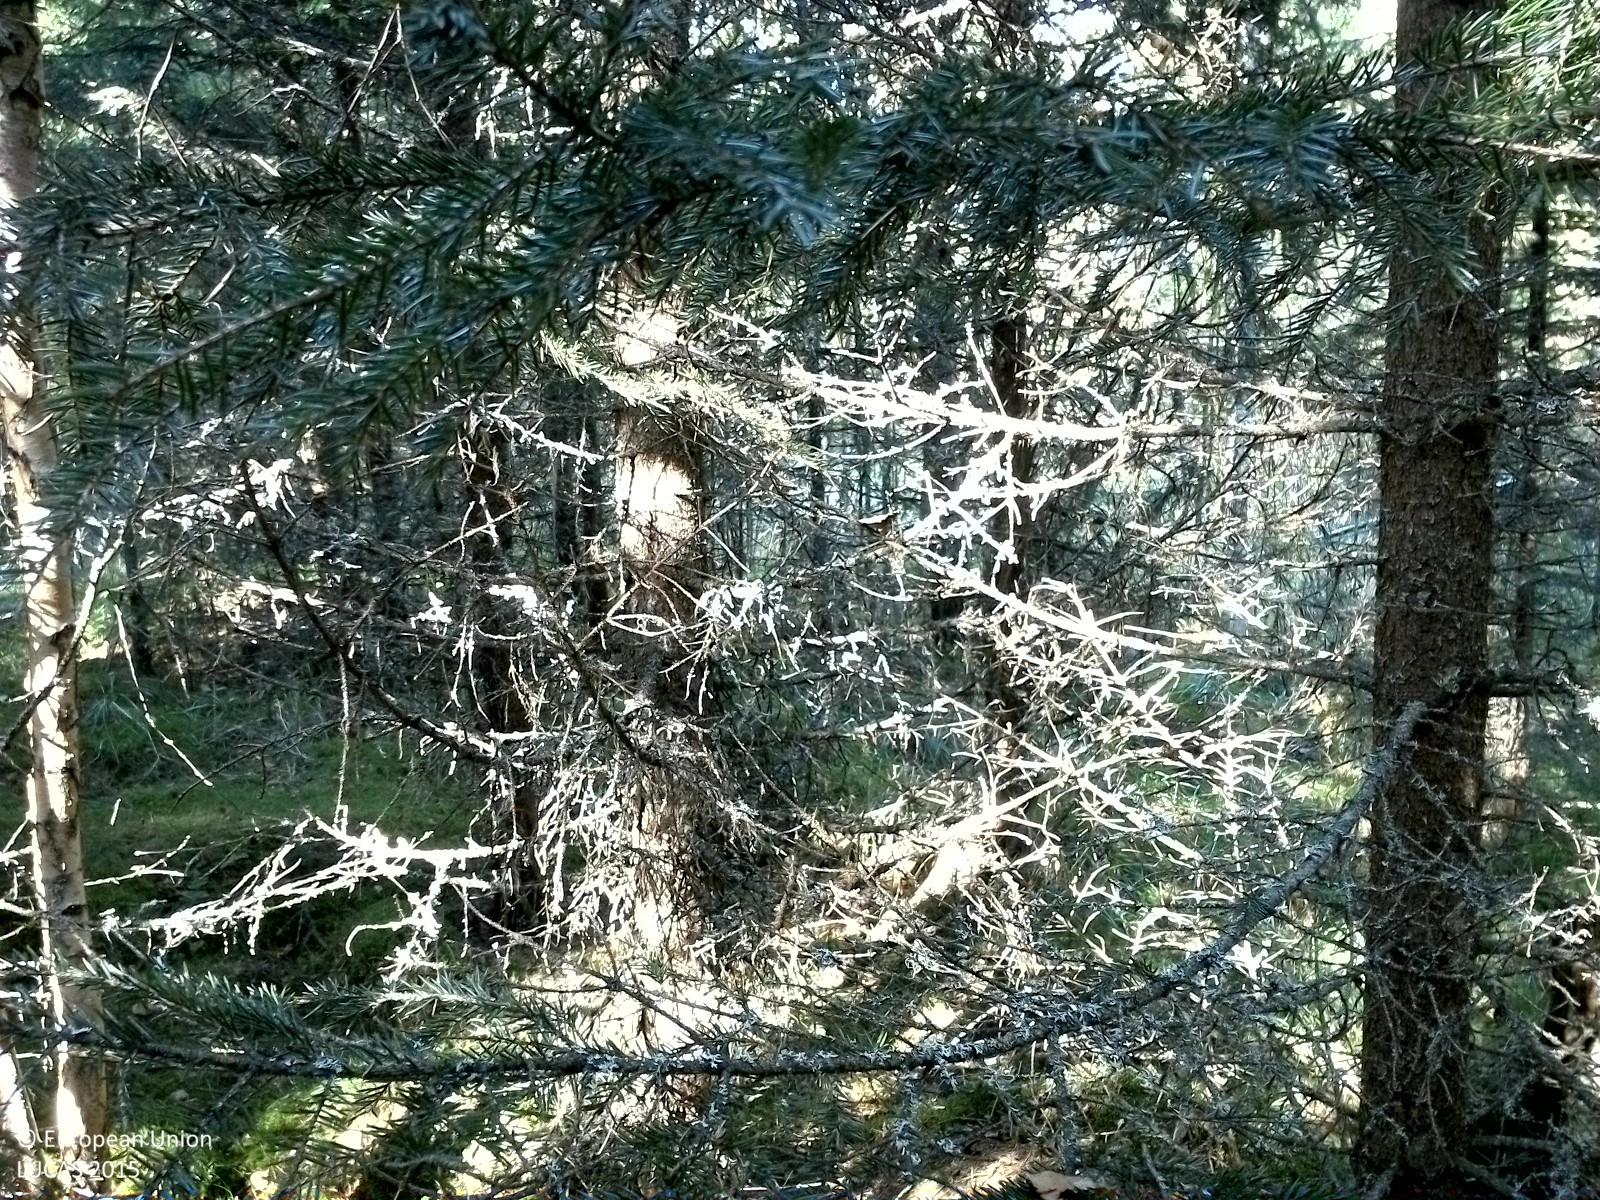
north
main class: Woodland
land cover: Spruce dominated mixed woodland
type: boreal forest
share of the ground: > 75 %
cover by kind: coniferous forest trees 45 %, broadleaved forest trees 25 %, herbaceous plants 15 %, lichens and mosses 15 %
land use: Forestry
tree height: > 5 m
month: September
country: SE
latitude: 62.5334
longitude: 16.3340
